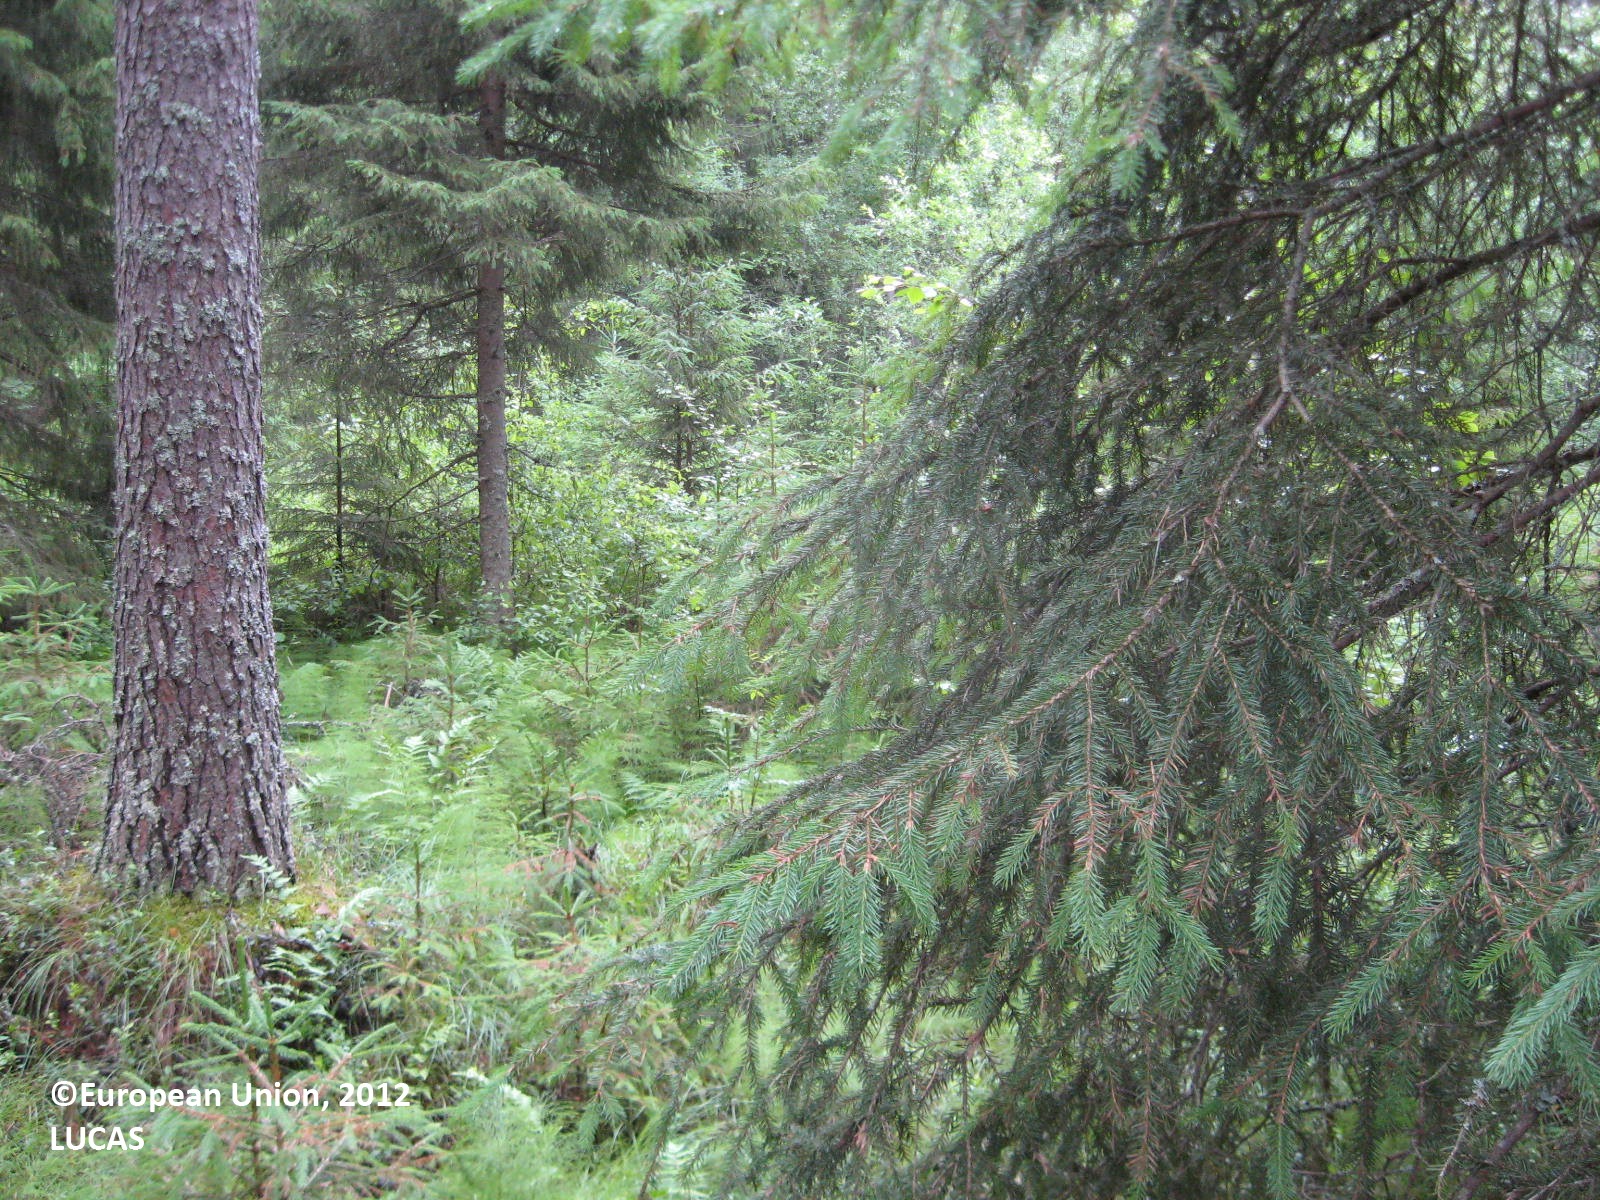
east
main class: Woodland
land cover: Other coniferous woodland
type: boreal forest
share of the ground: > 75 %
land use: Forestry
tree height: > 5 m
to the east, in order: Other coniferous woodland; Shruby margins; Tracks; Shruby margins; Lines of trees; Ditches and canals; Spruce dominated coniferous woodland; Ditches and canals; Spruce dominated coniferous woodland; Ditches and canals; Spruce dominated coniferous woodland; Pine dominated coniferous woodland; Pine dominated mixed woodland
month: July
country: FI
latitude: 62.3588
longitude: 21.6583
